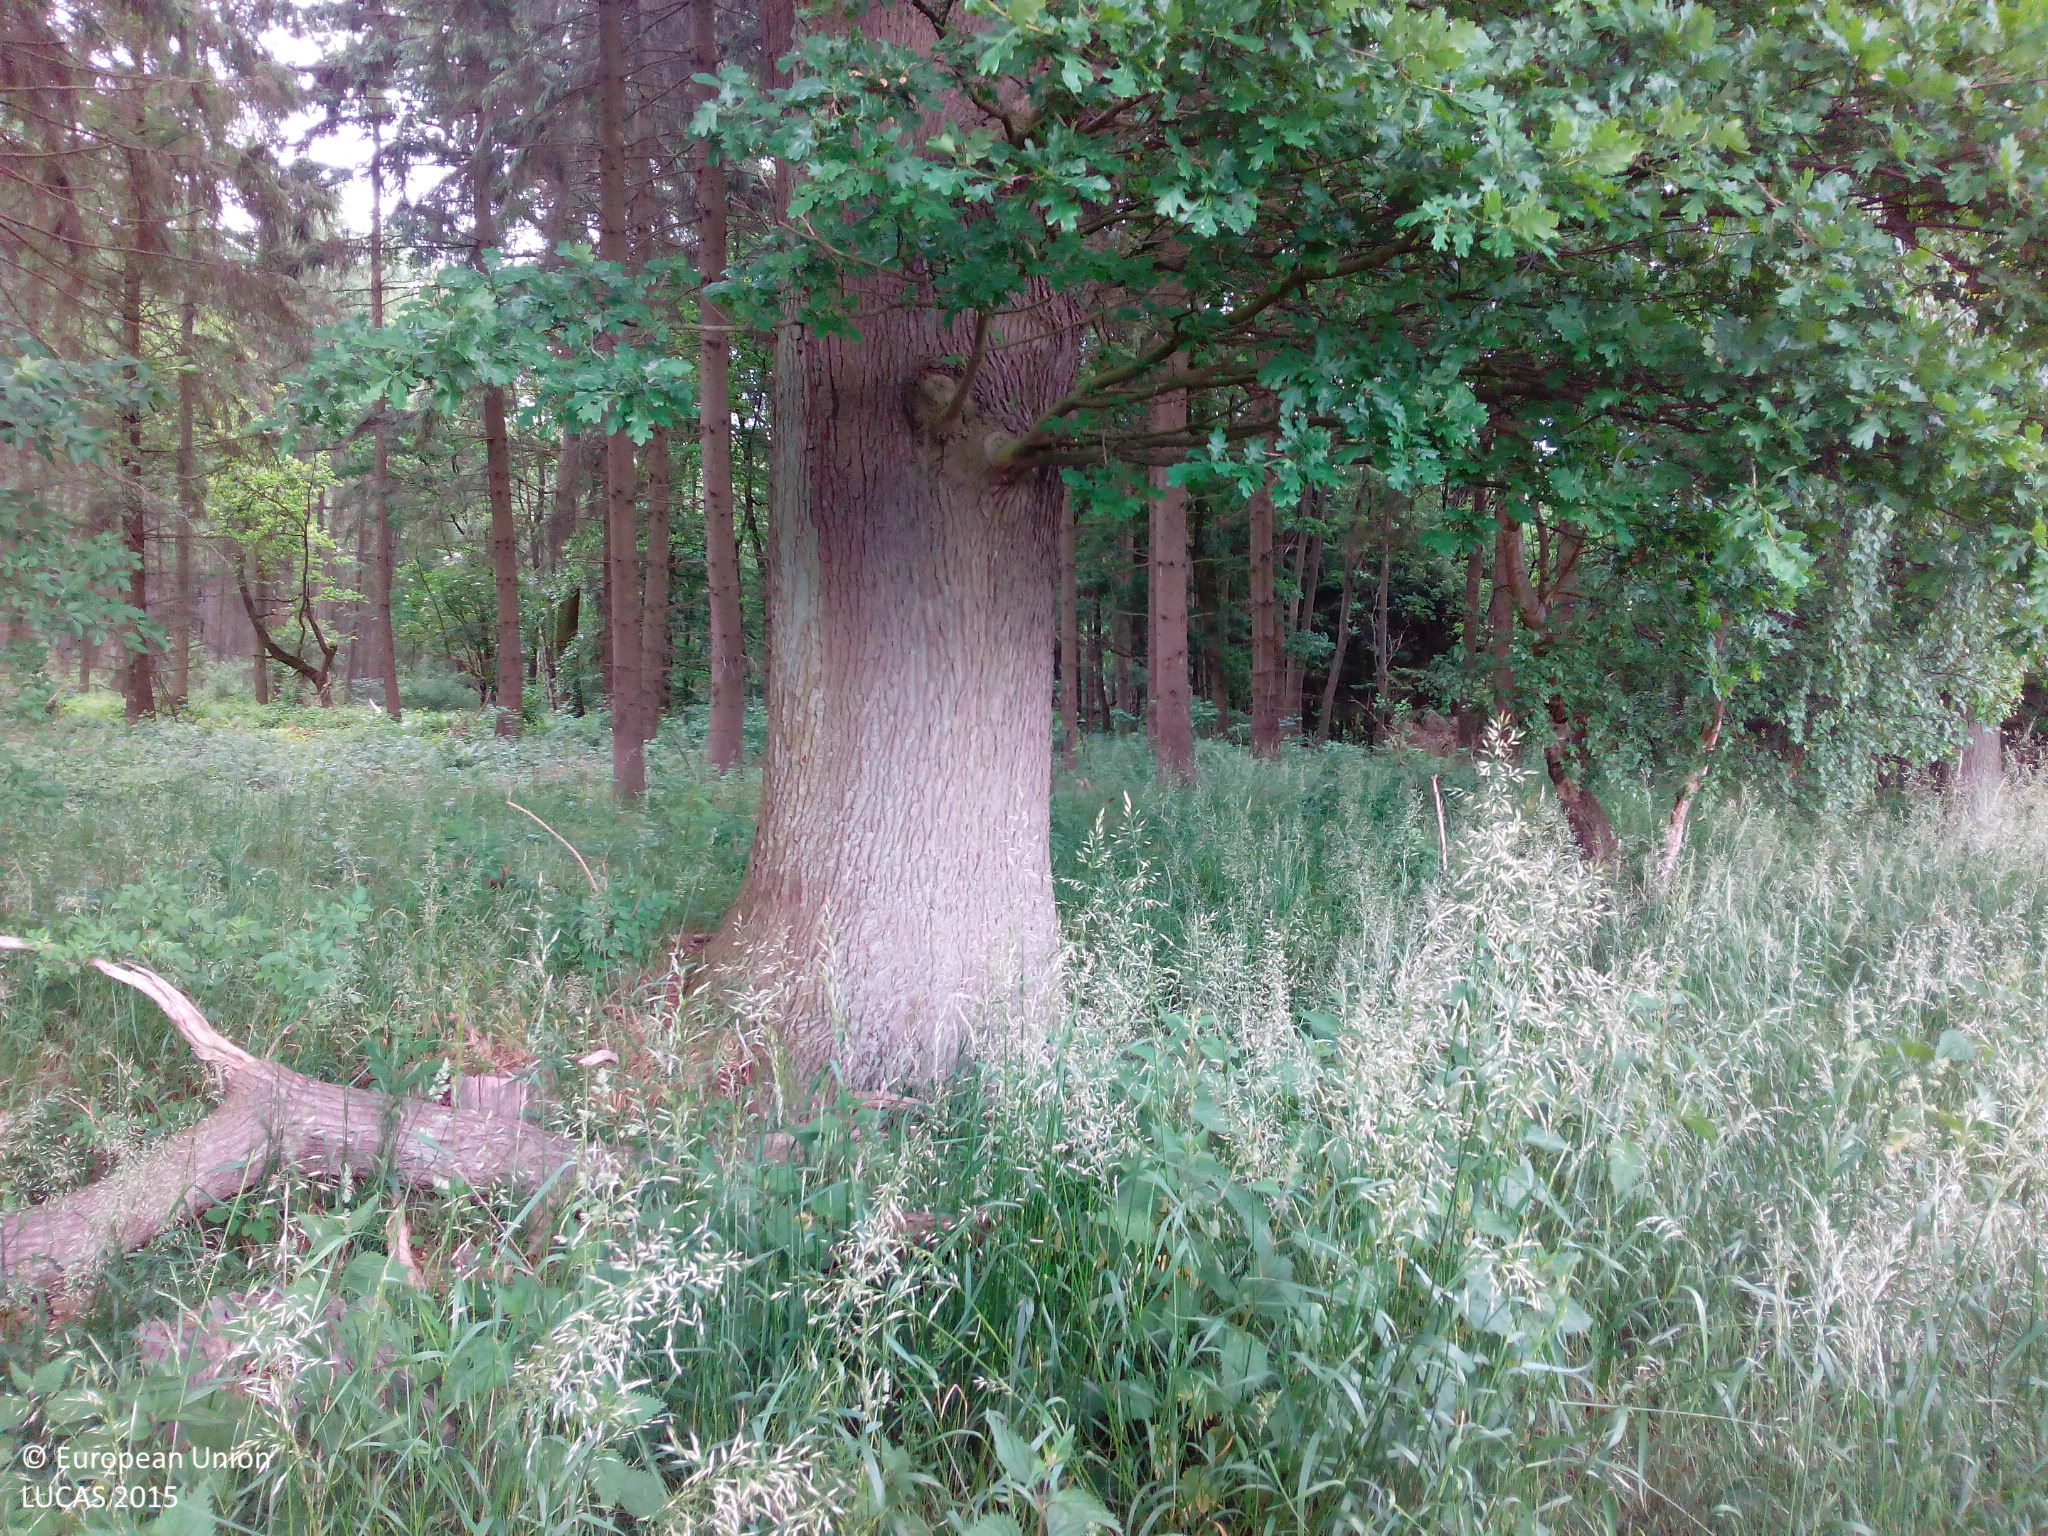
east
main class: Cropland
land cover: Rape and turnip rape
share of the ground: > 75 %
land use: Agriculture (excluding fallow land and kitchen gardens)
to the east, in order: Rape and turnip rape; Groves; Spruce dominated coniferous woodland; Ditches and canals; Broadleaved woodland; Spruce dominated coniferous woodland; Broadleaved woodland
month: June
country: DE
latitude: 53.6300
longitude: 11.1638
